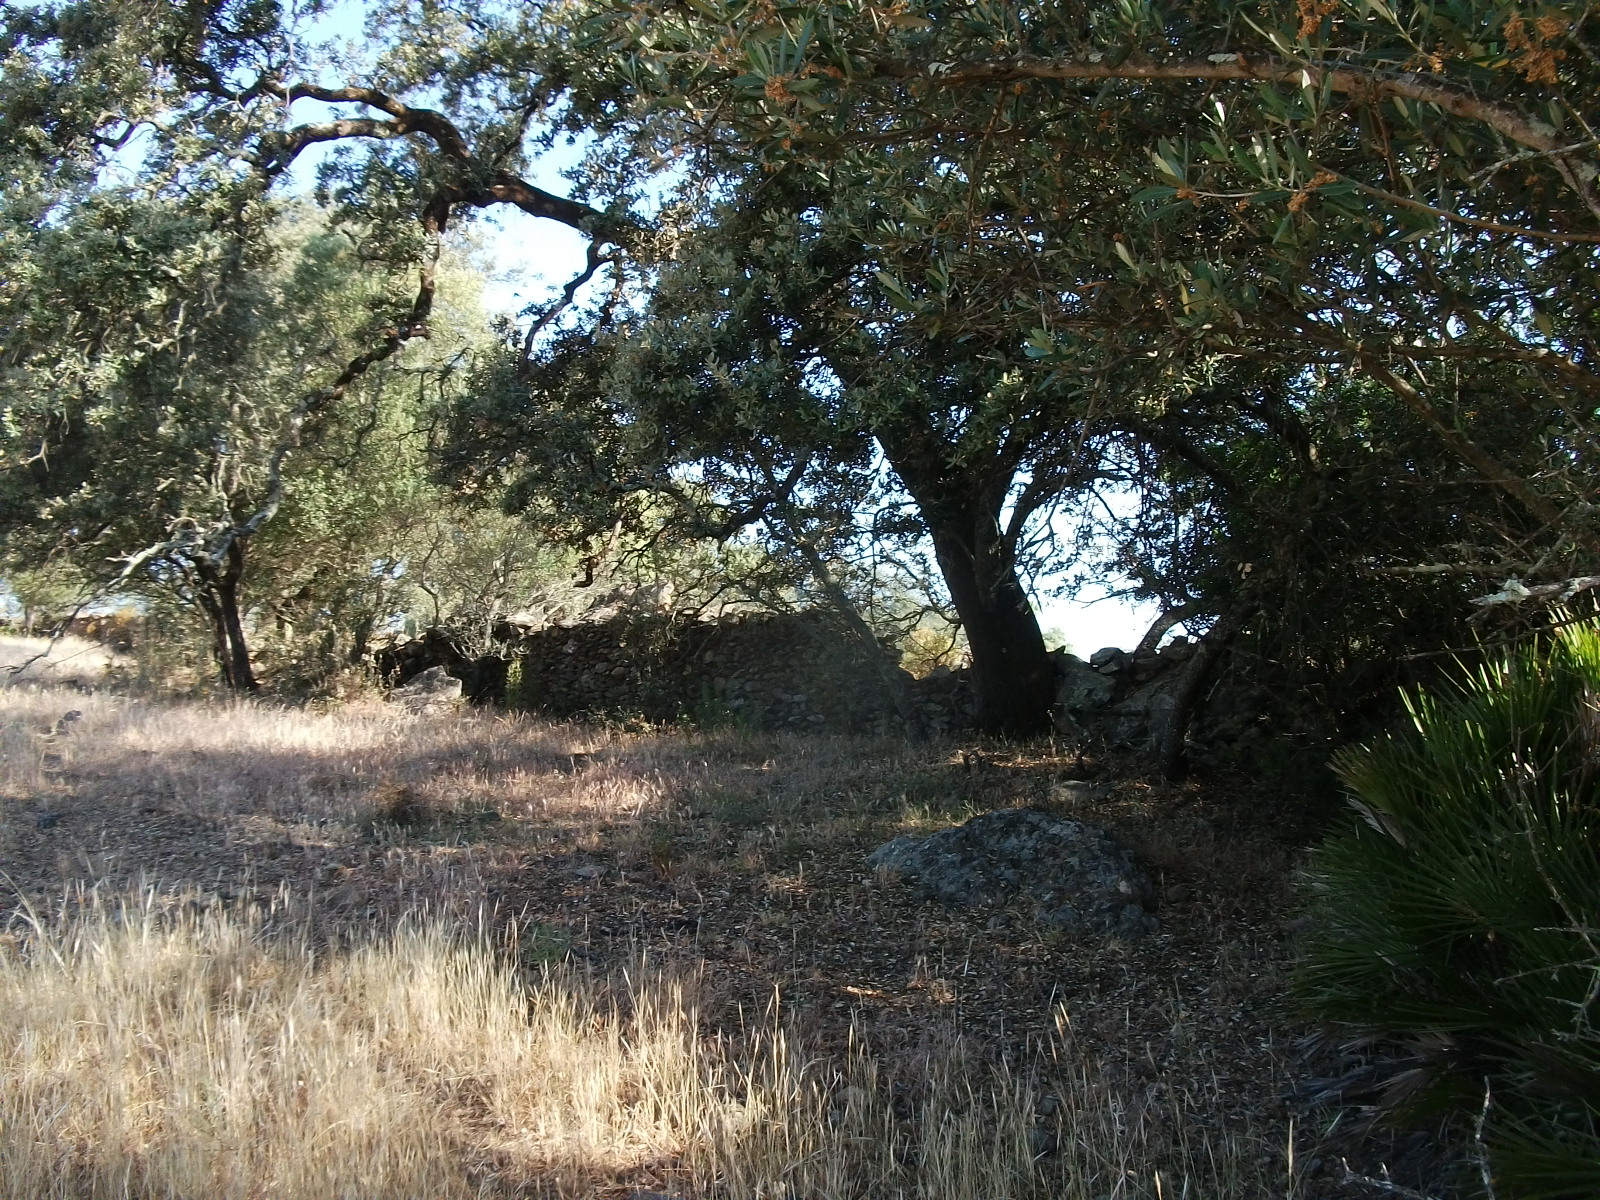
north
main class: Woodland
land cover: Broadleaved woodland
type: broadleaved evergreen forest
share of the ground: 10 - 25 %
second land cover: Grassland without tree/shrub cover
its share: > 75 %
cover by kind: herbaceous plants 85 %, broadleaved forest trees 15 %
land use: Forestry
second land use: Agriculture (excluding fallow land and kitchen gardens)
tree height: > 5 m
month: May
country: ES
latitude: 37.6106
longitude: -6.6814
